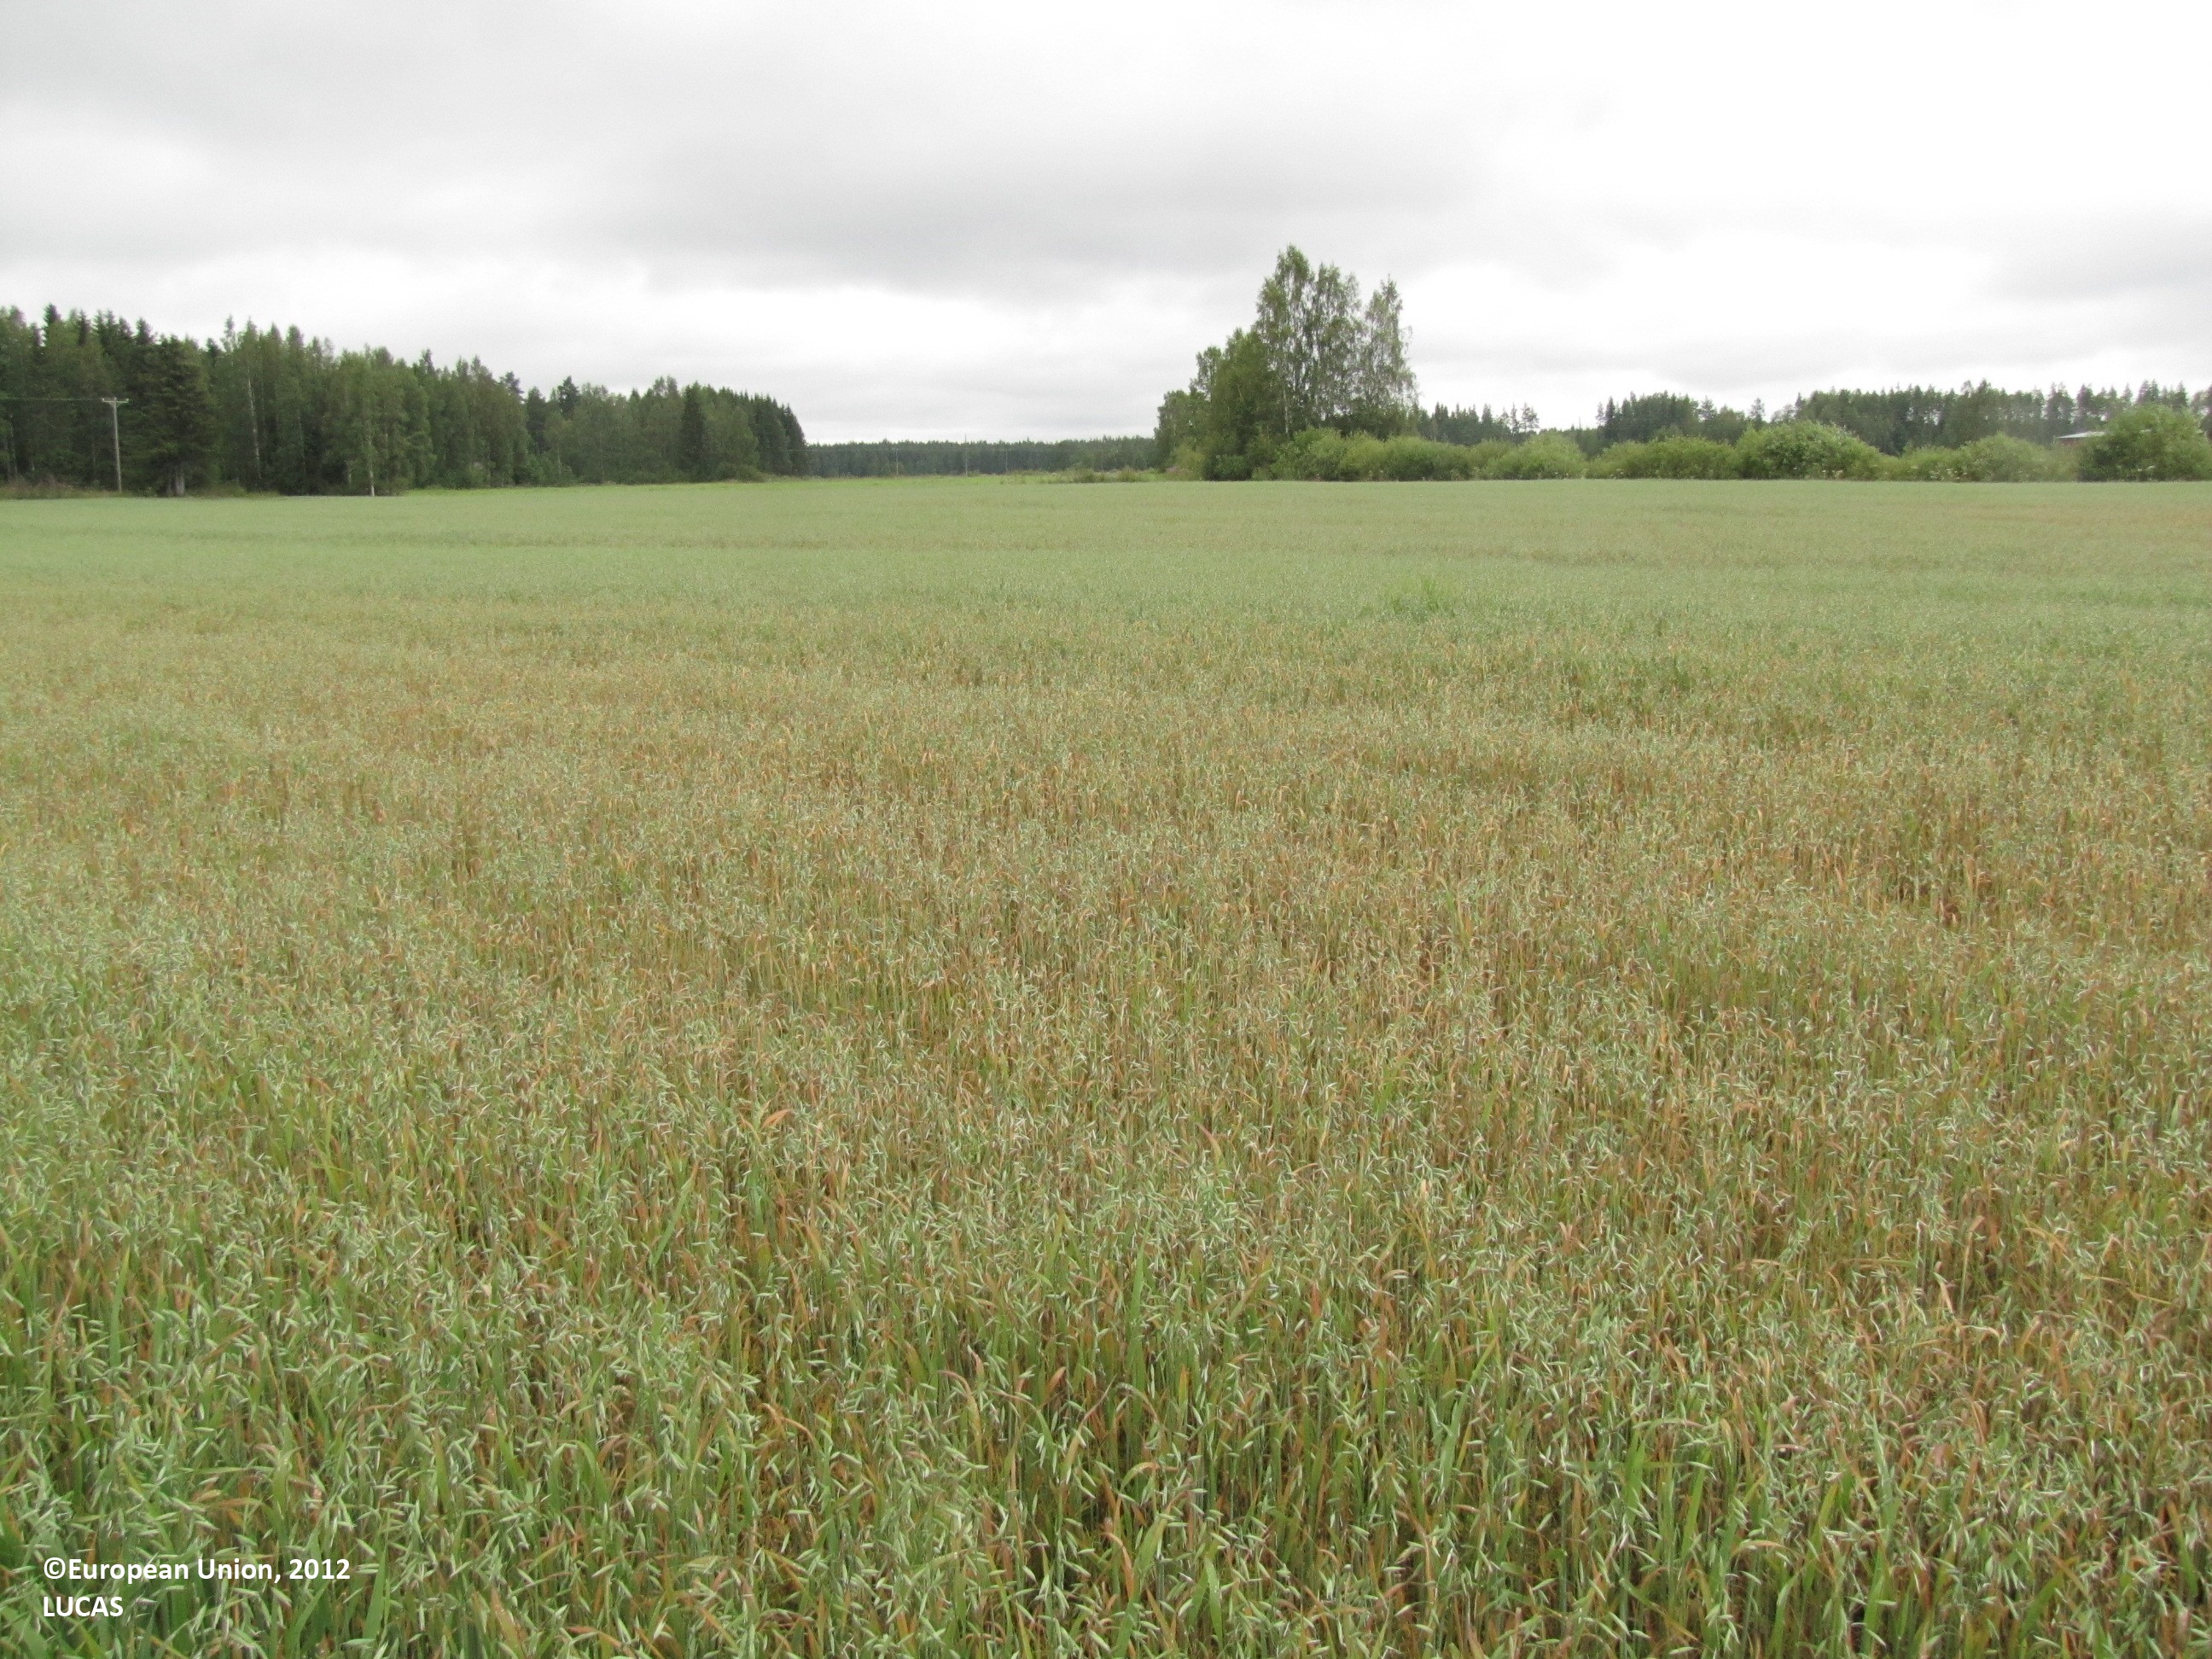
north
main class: Cropland
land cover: Oats
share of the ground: > 75 %
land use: Agriculture (excluding fallow land and kitchen gardens)
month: July
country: FI
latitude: 62.1926
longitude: 22.9973
